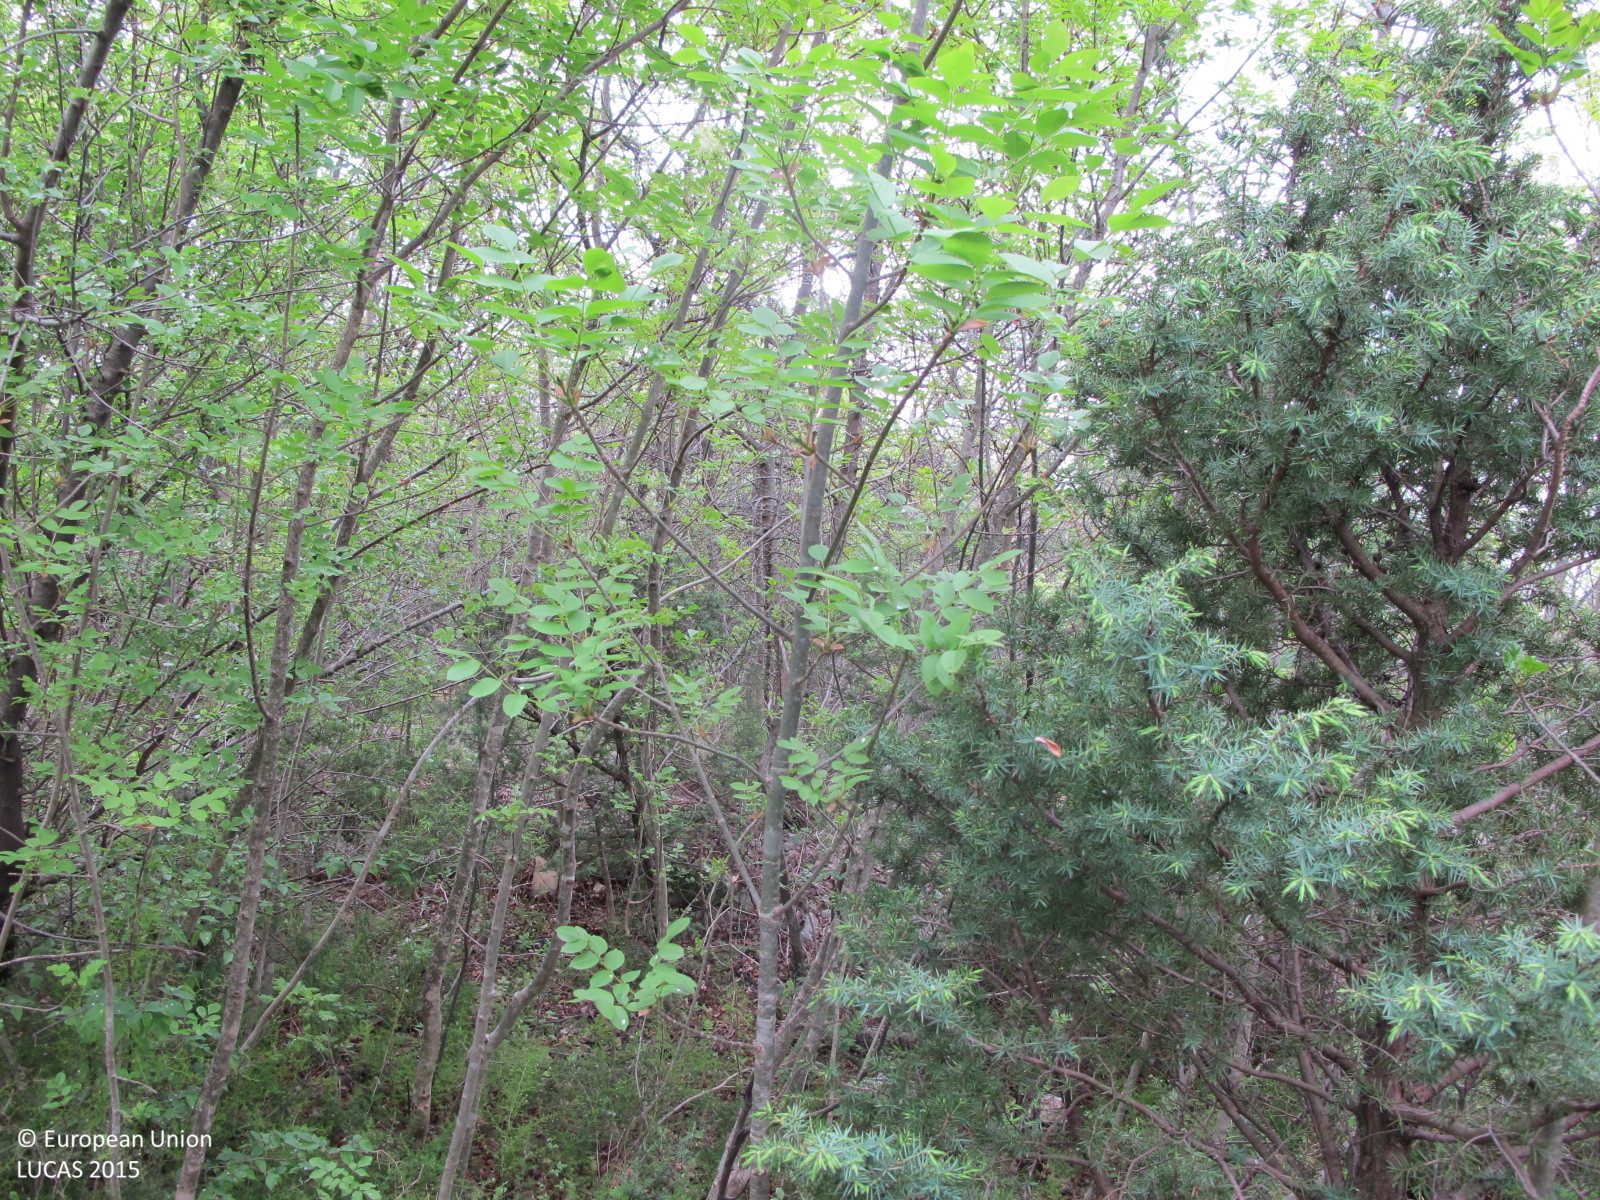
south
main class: Woodland
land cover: Broadleaved woodland
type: acidophilous oak and oak-birch forest
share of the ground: > 75 %
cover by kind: broadleaved forest trees 90 %, coniferous forest trees 5 %, shrubs 5 %
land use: Semi-natural and natural areas not in use
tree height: > 5 m
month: April
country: HR
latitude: 45.2027
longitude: 14.6669
